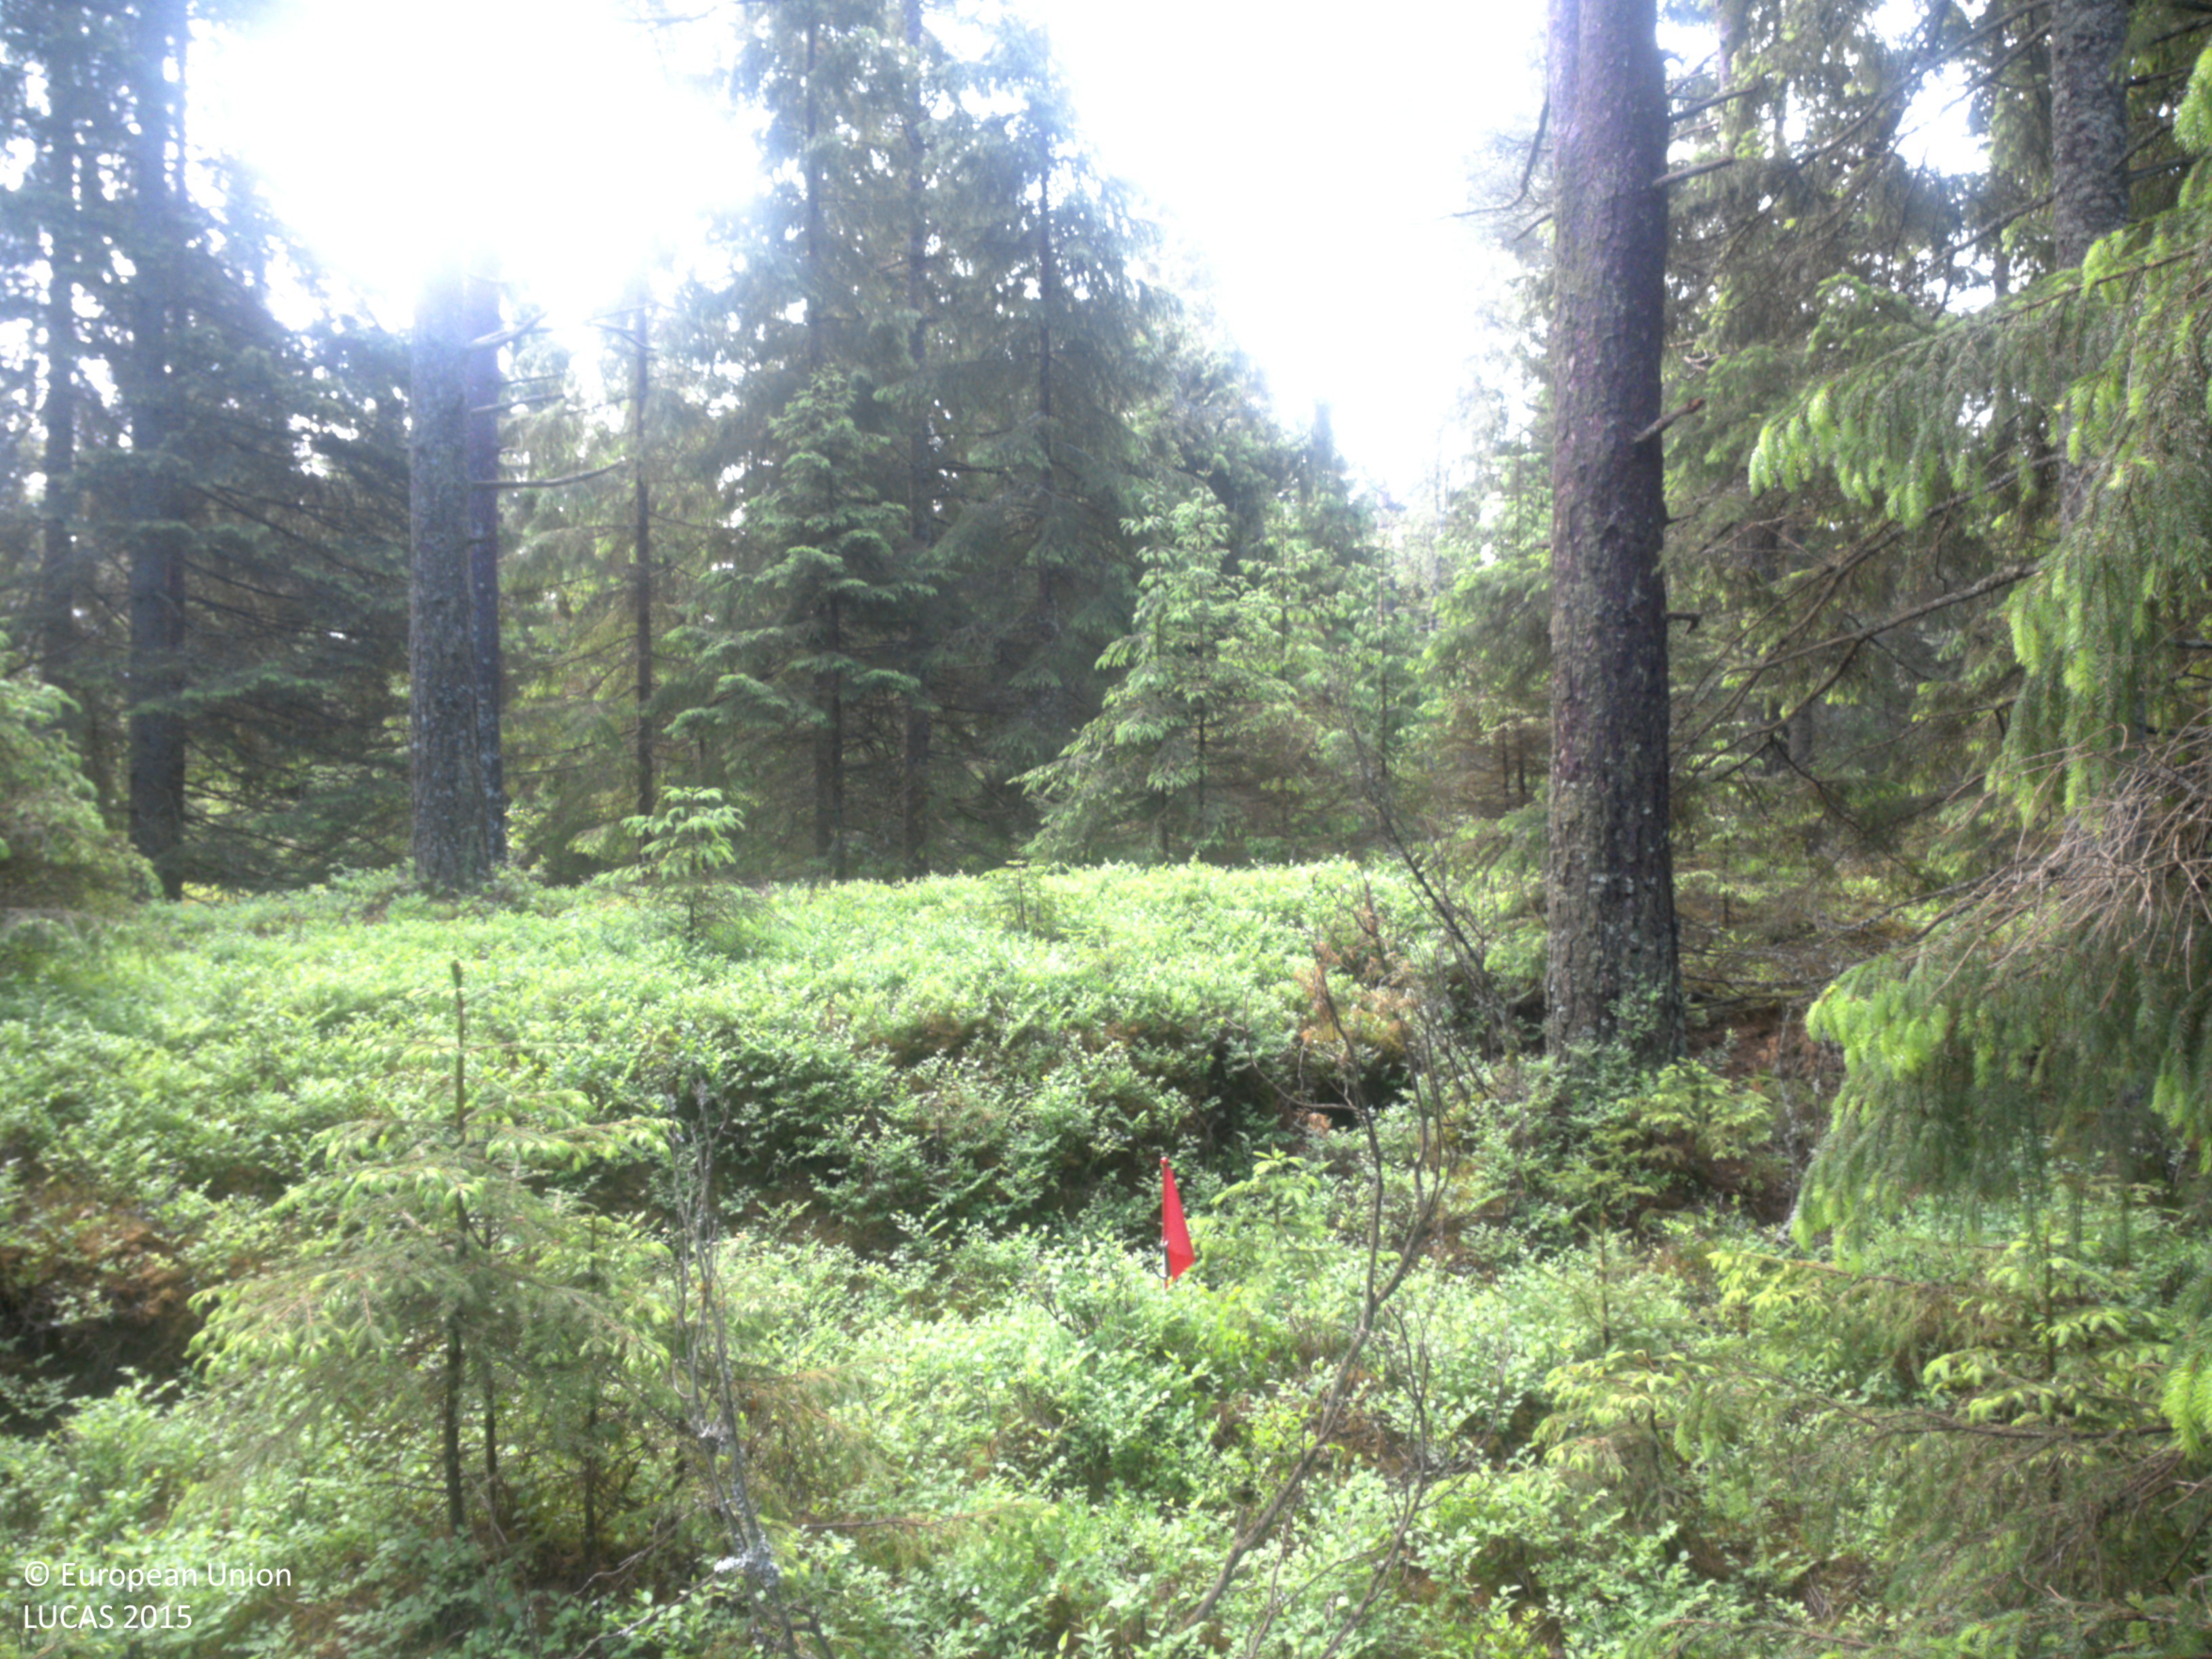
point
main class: Woodland
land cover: Spruce dominated coniferous woodland
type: boreal forest
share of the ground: 50 - 75 %
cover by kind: coniferous forest trees 50 %, lichens and mosses 30 %, shrubs 20 %
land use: Forestry
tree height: > 5 m
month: June
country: SE
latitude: 58.4054
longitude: 11.7932
